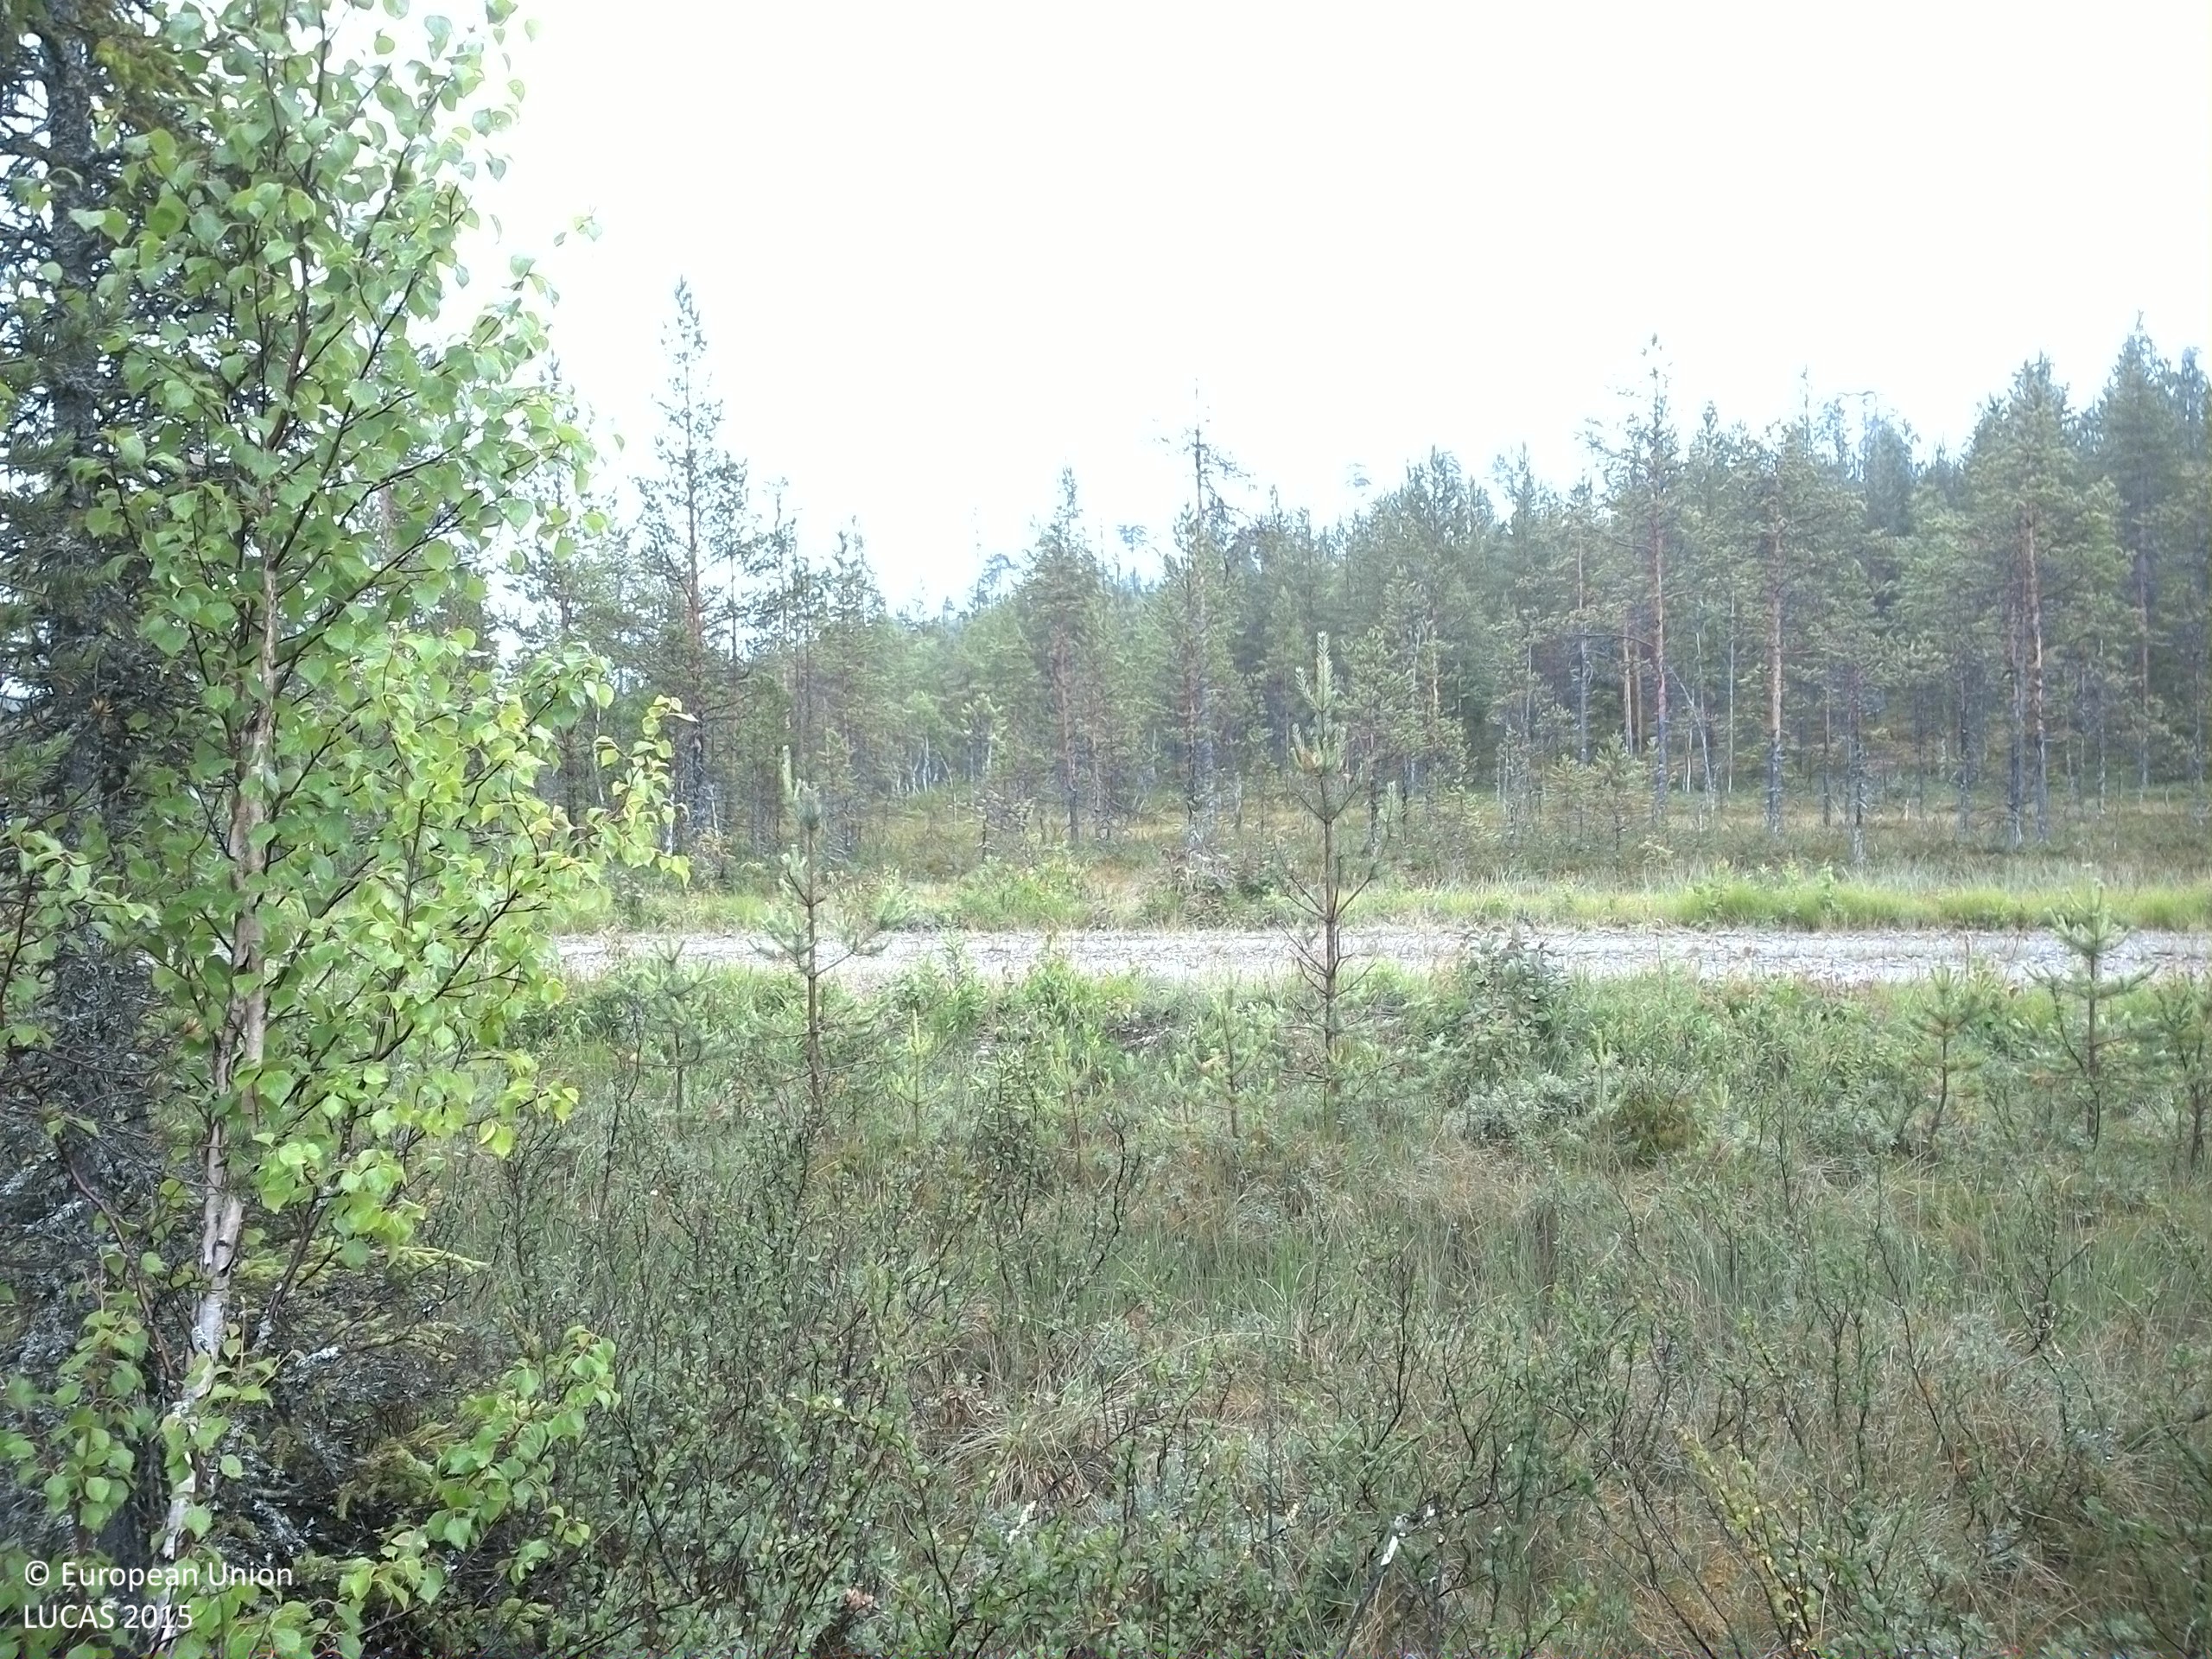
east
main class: Woodland
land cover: Pine dominated mixed woodland
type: boreal forest
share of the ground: 25 - 50 %
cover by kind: shrubs 40 %, lichens and mosses 20 %, coniferous forest trees 15 %, broadleaved forest trees 15 %, herbaceous plants 10 %
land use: Semi-natural and natural areas not in use
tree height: < 5 m
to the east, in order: Pine dominated mixed woodland; Ditches and canals; Broadleaved woodland; Paved roads, cycling and walking lanes; Broadleaved woodland; Ditches and canals; Pine dominated coniferous woodland; Peatbogs; Pine dominated coniferous woodland; Pine dominated mixed woodland
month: July
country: SE
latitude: 63.6656
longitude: 17.3475
